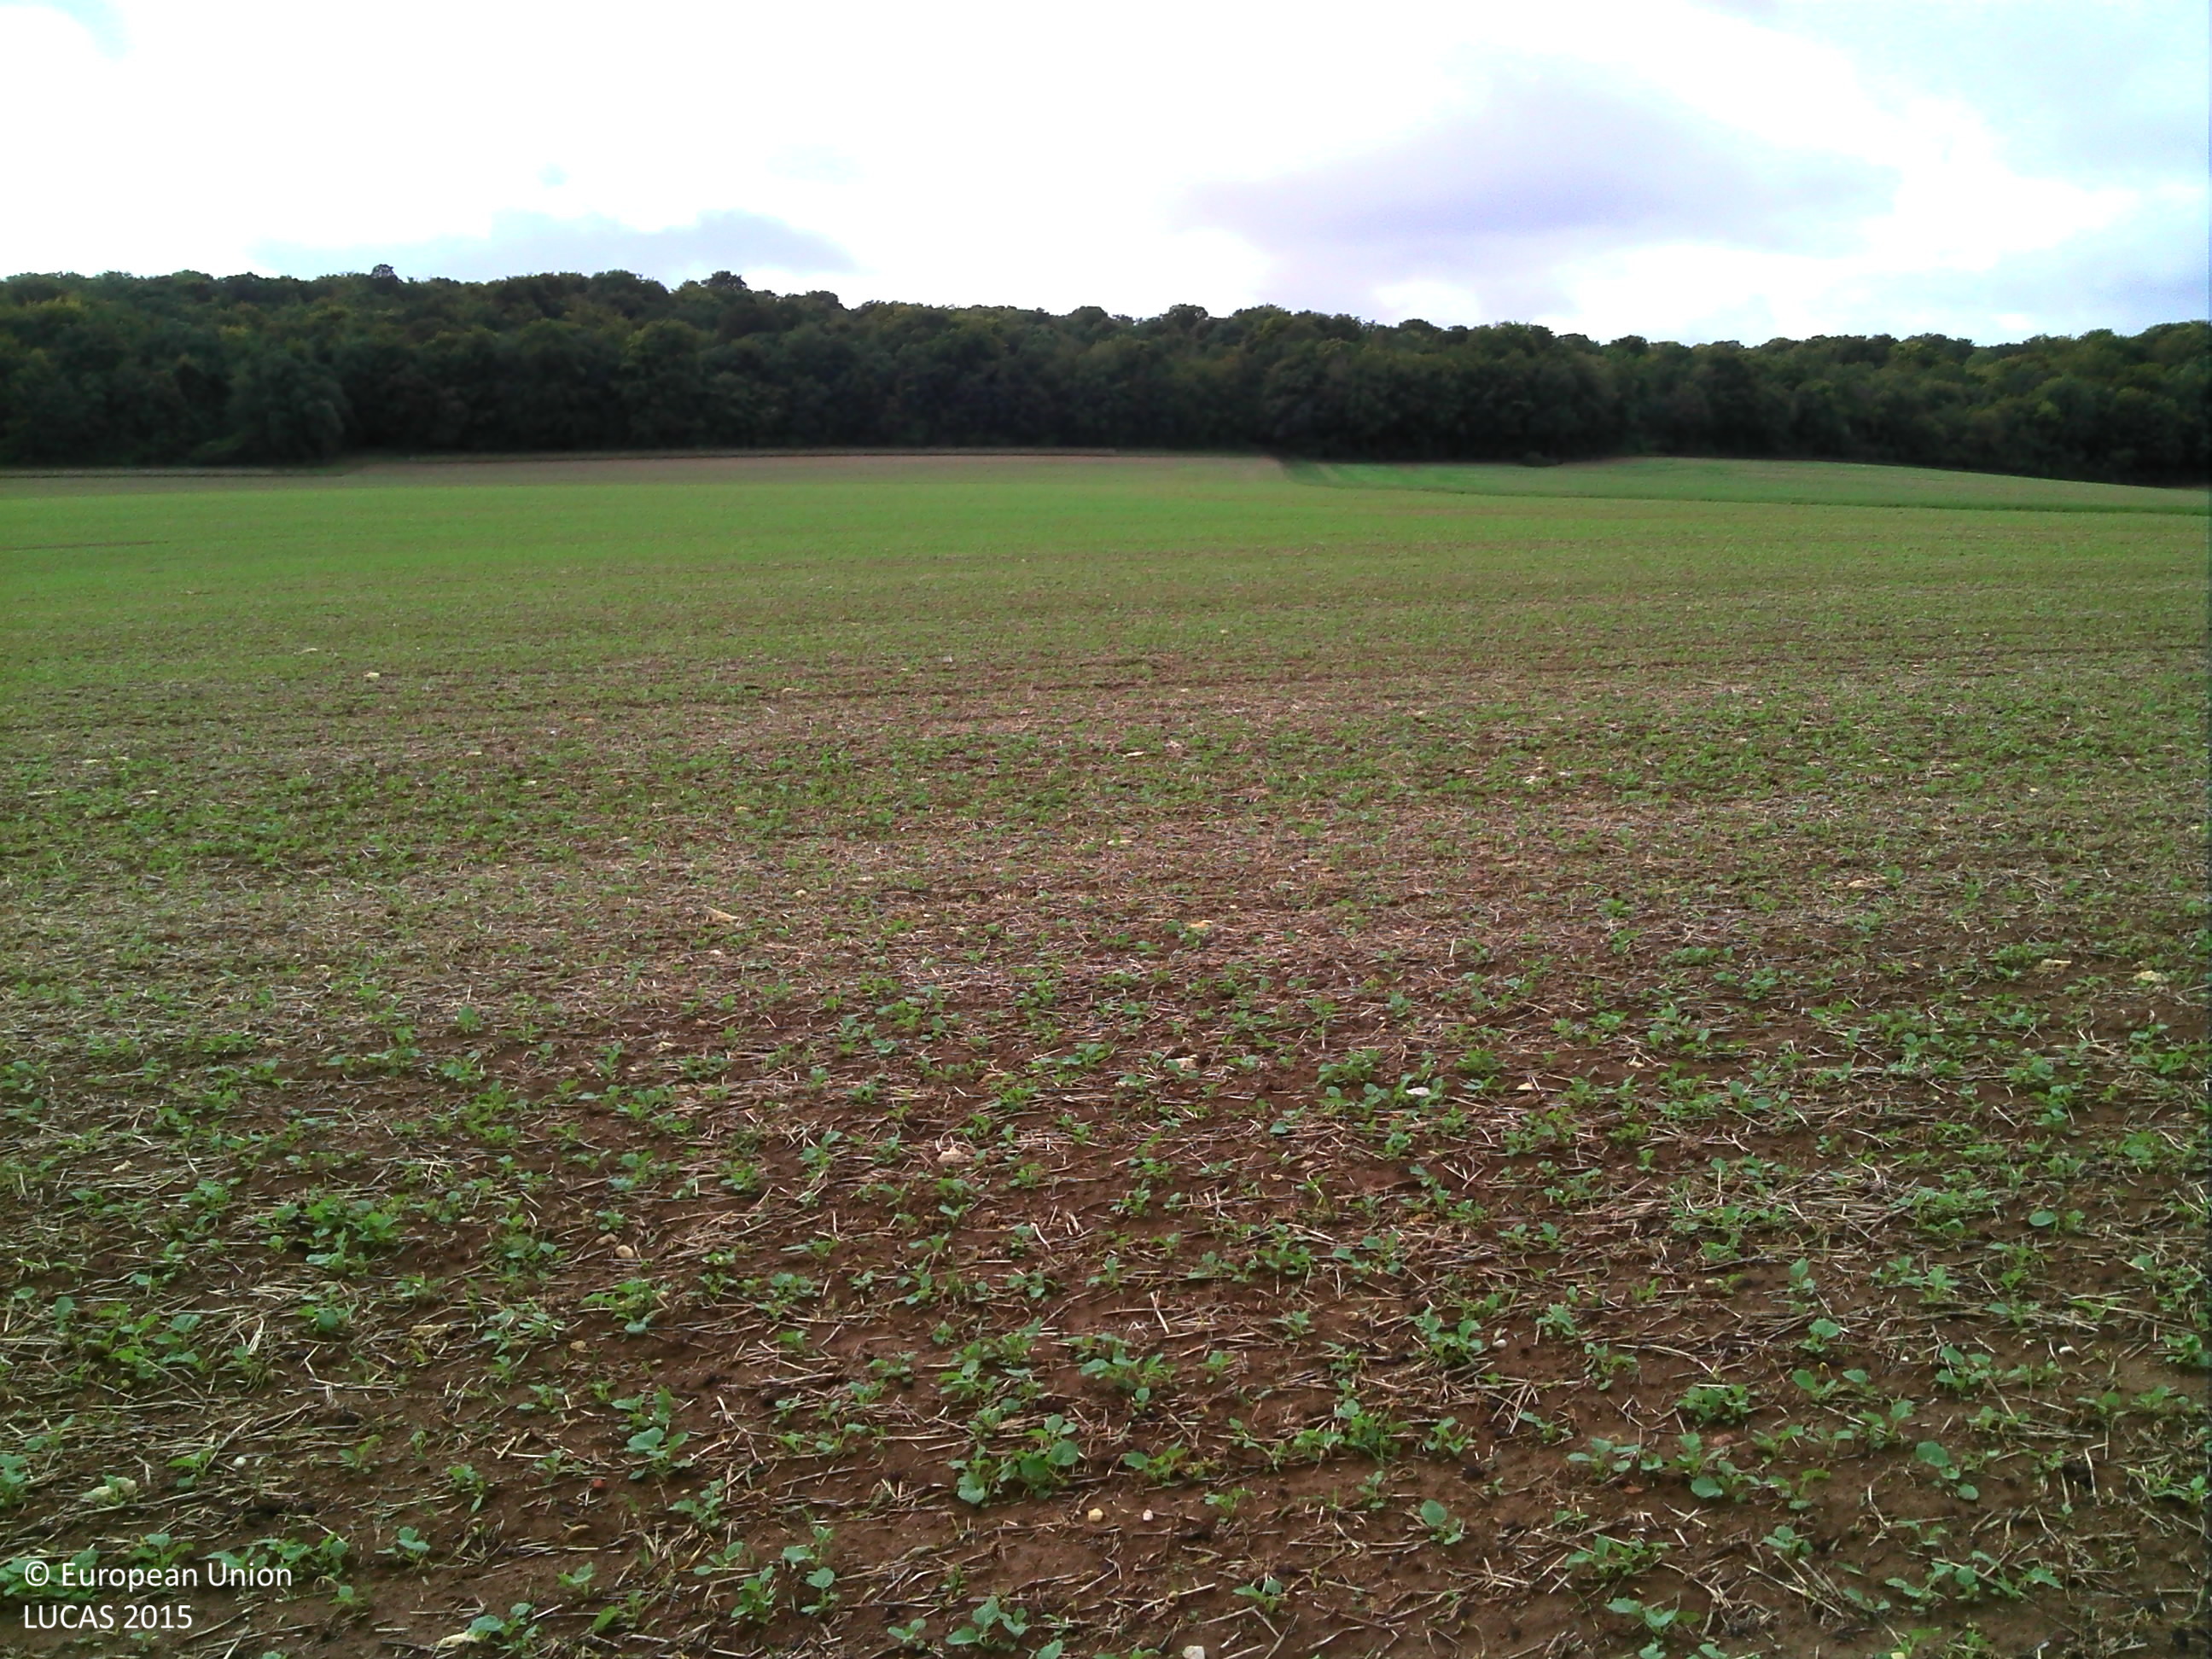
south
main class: Cropland
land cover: Rape and turnip rape
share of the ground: 25 - 50 %
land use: Agriculture (excluding fallow land and kitchen gardens)
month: September
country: FR
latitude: 48.2971
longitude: 4.7544
